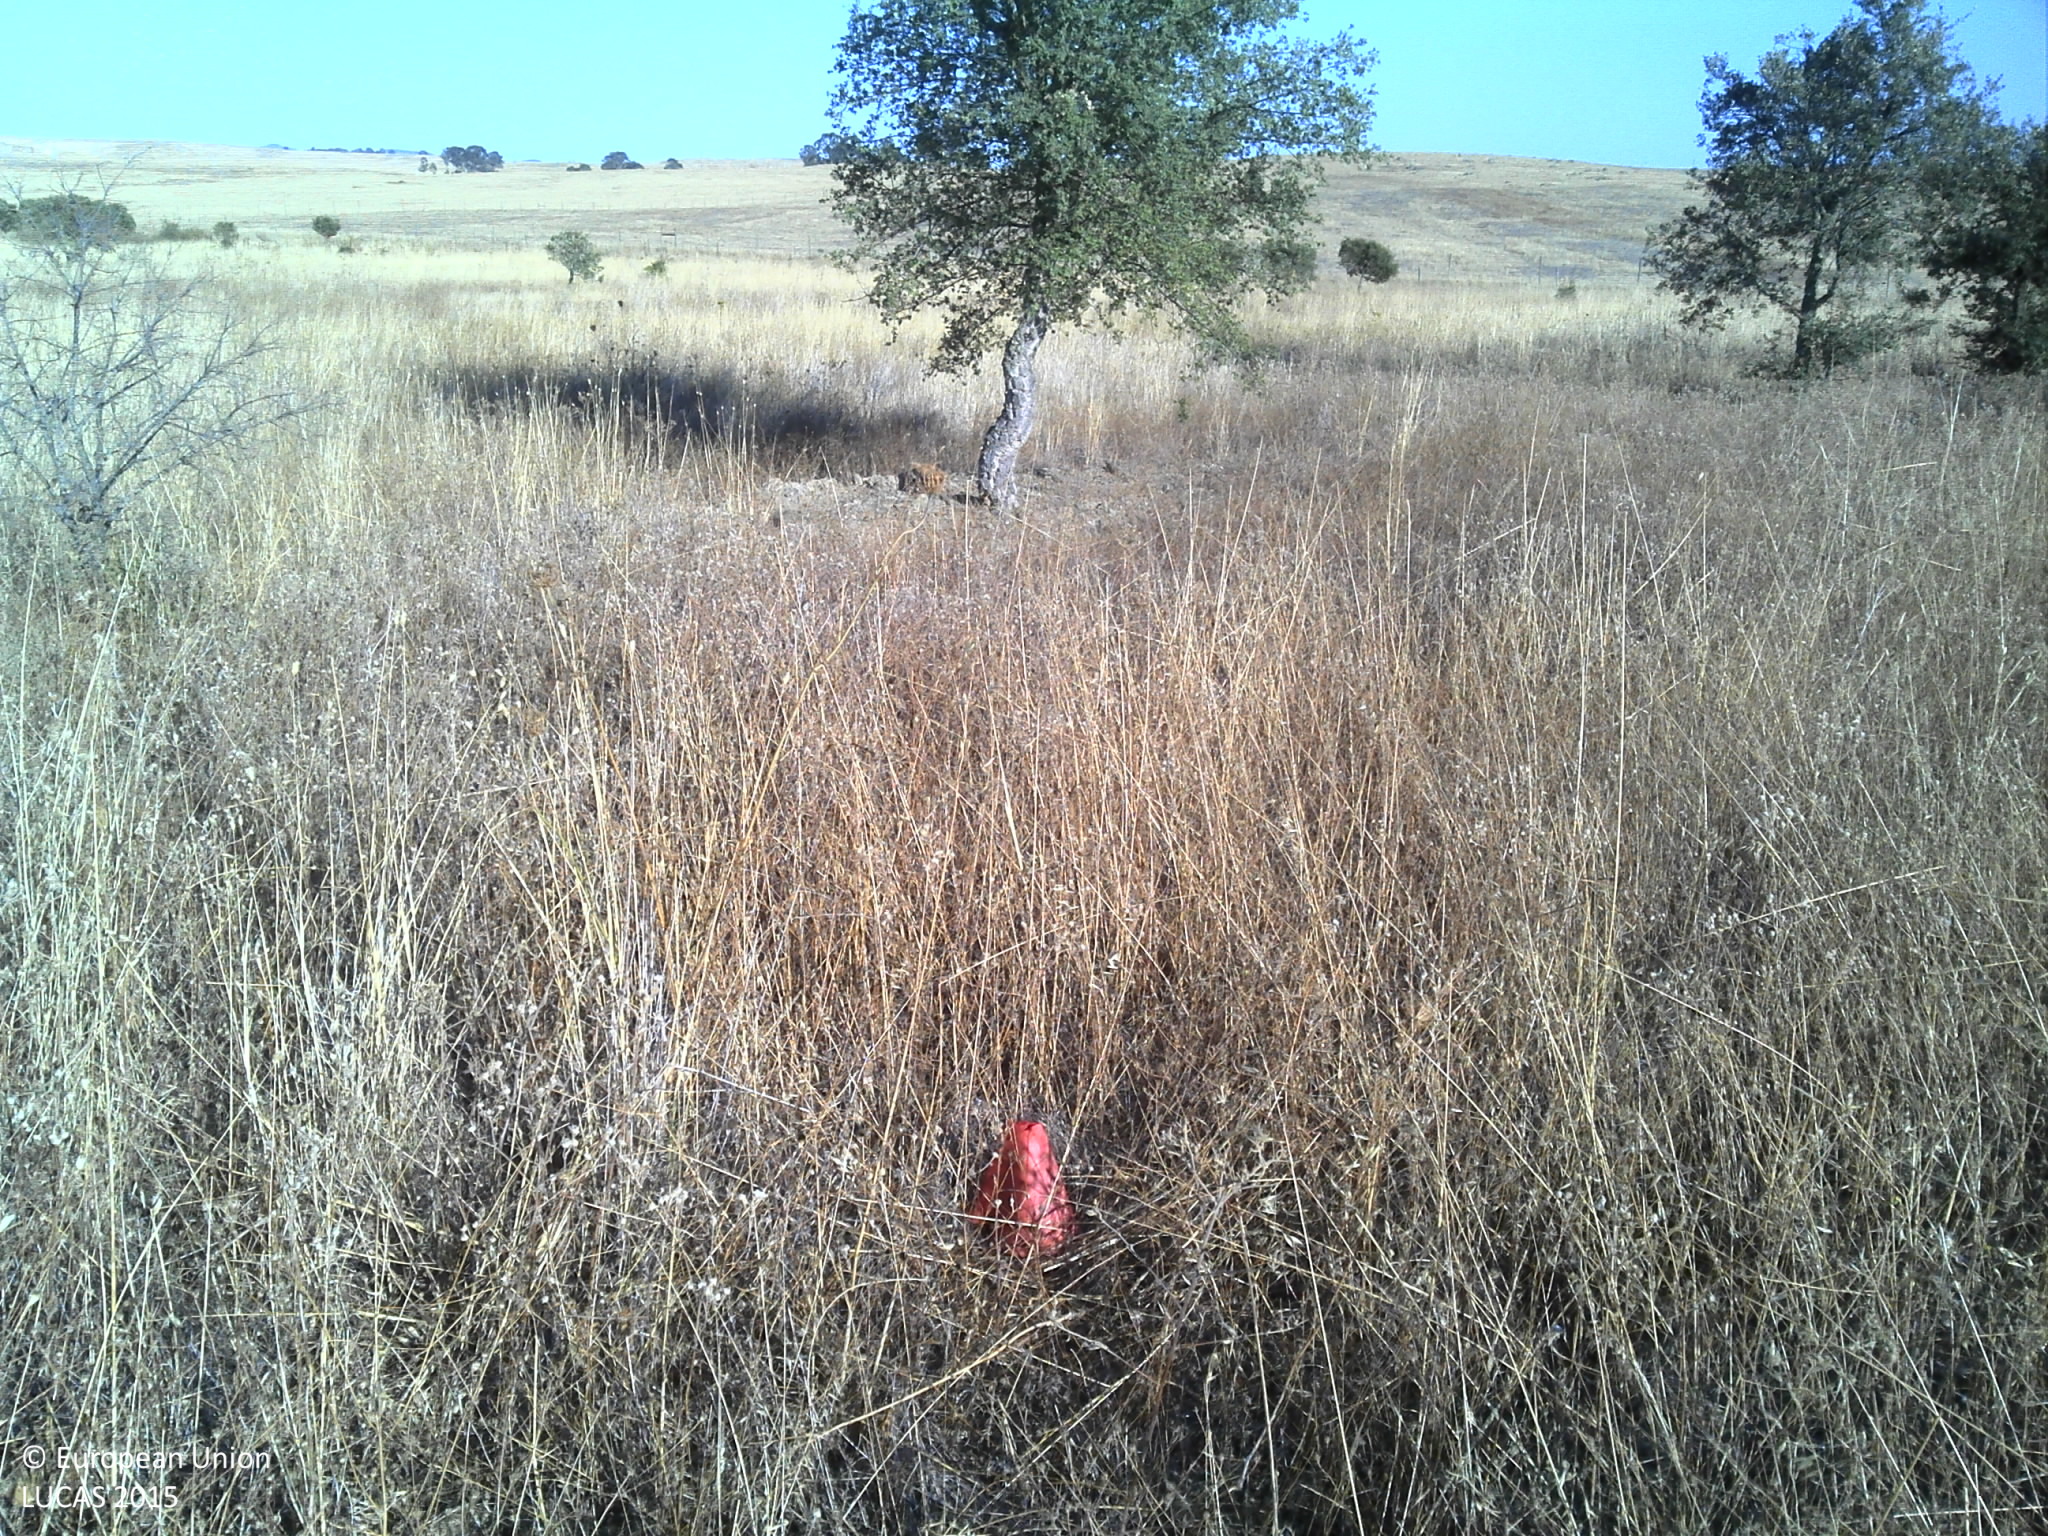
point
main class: Woodland
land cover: Broadleaved woodland
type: broadleaved evergreen forest
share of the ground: 25 - 50 %
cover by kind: broadleaved forest trees 75 %, herbaceous plants 15 %, unconsolidated bare surface 10 %
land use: Forestry
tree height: < 5 m
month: July
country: PT
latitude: 37.7075
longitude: -7.9570
